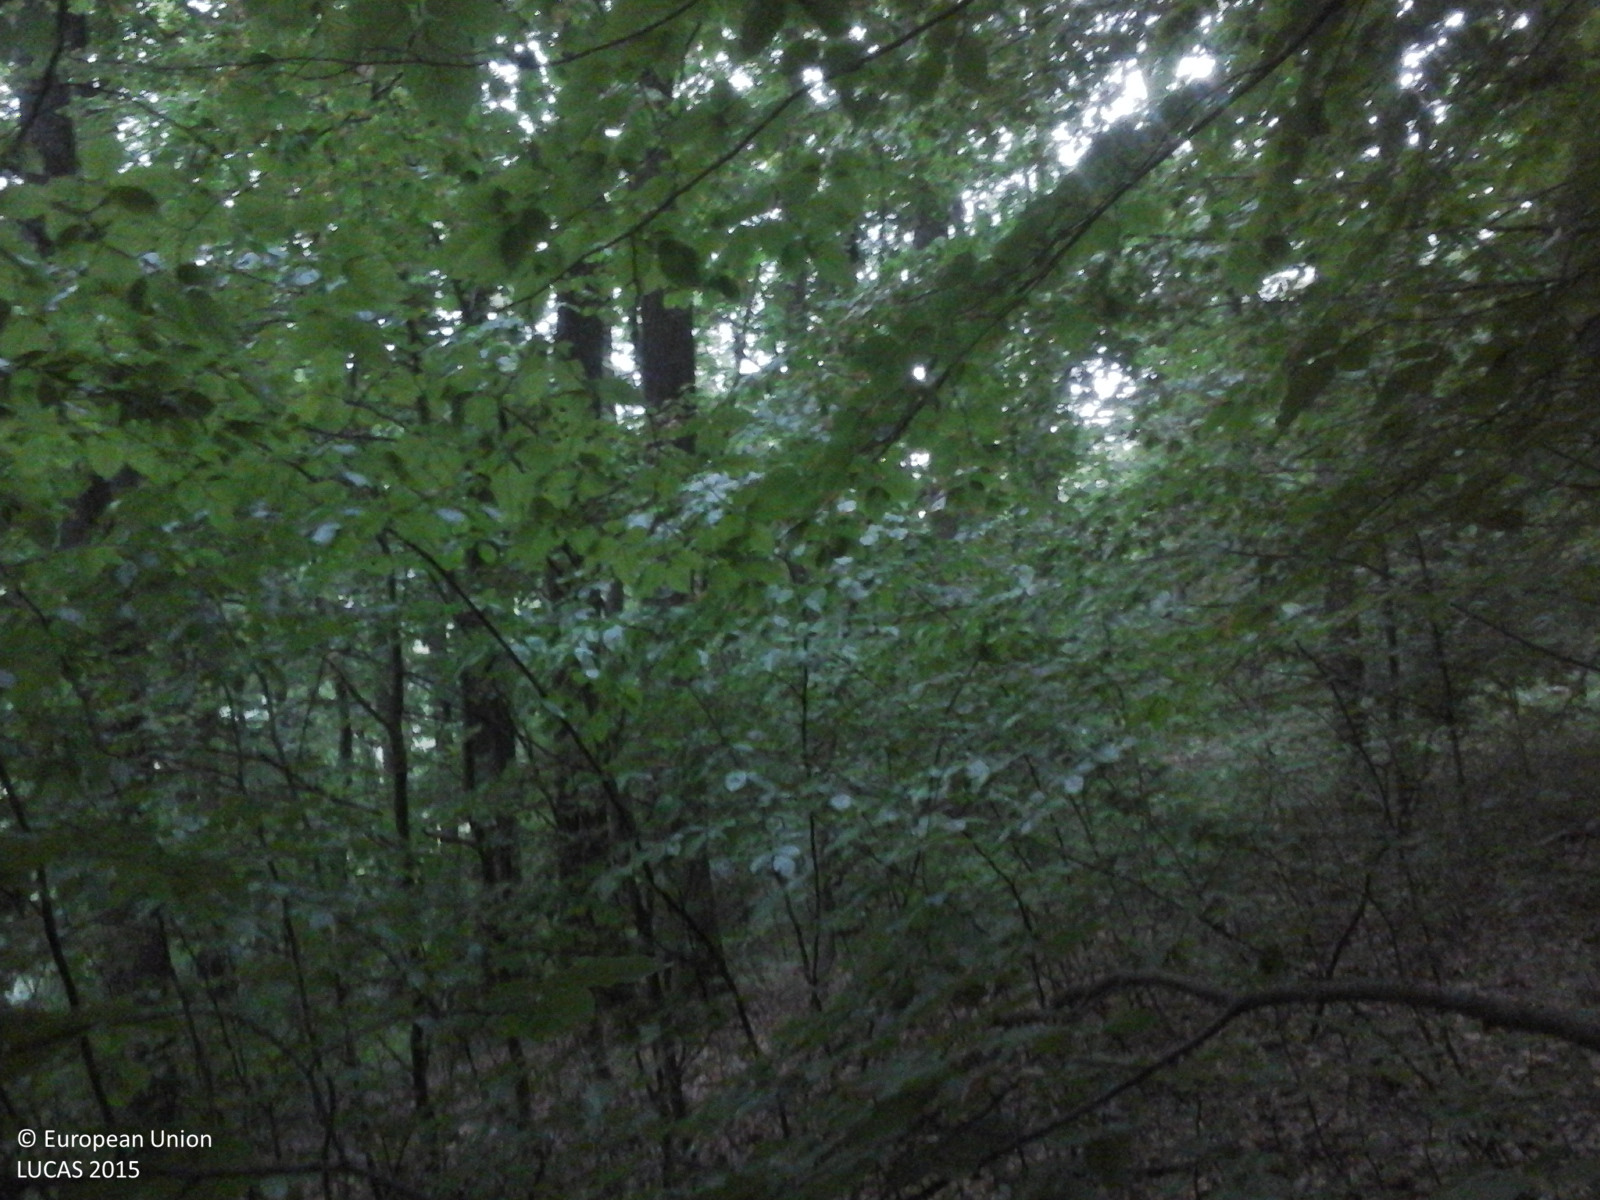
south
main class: Woodland
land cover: Broadleaved woodland
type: beech forest
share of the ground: > 75 %
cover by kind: broadleaved forest trees 100 %
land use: Forestry
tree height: > 5 m
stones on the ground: < 10 %
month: June
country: RO
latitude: 47.2356
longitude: 26.3163
